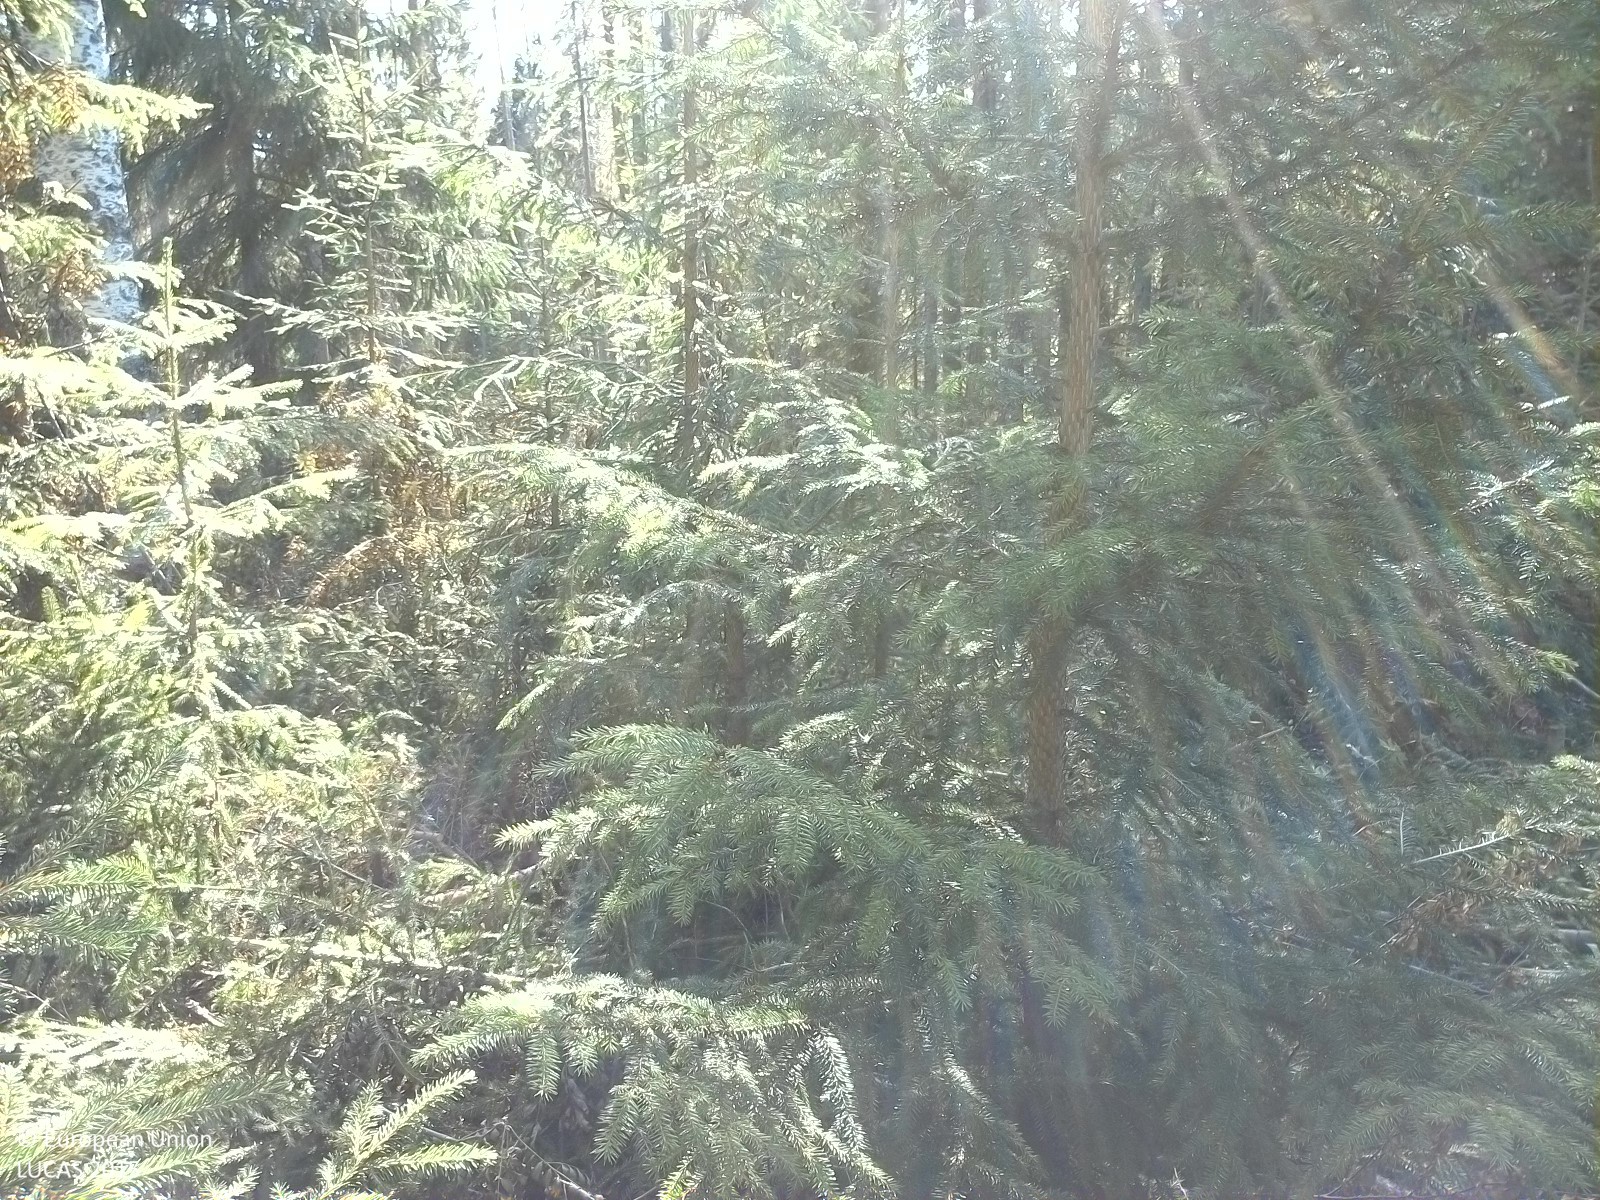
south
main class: Woodland
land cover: Spruce dominated mixed woodland
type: boreal forest
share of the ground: 50 - 75 %
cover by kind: coniferous forest trees 40 %, herbaceous plants 40 %, broadleaved forest trees 15 %
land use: Forestry
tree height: > 5 m
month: August
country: SE
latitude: 62.4039
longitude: 16.8105
